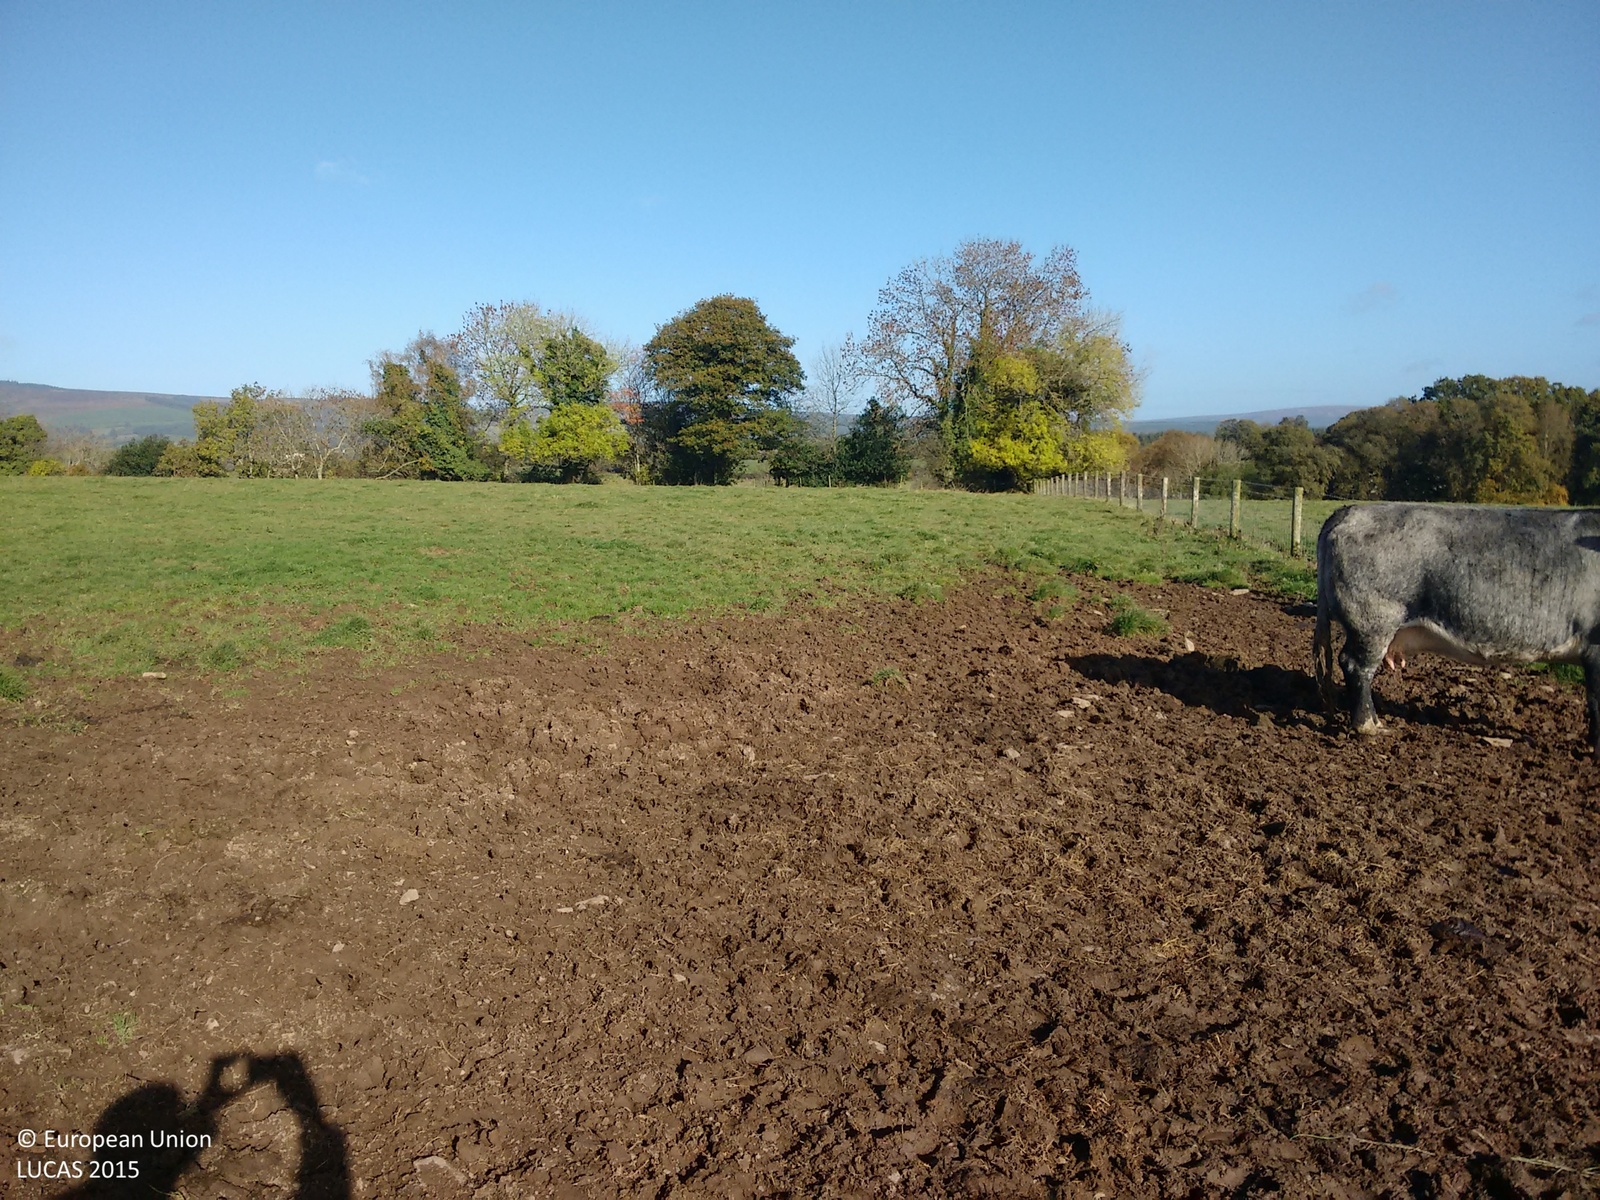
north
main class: Grassland
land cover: Grassland without tree/shrub cover
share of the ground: > 75 %
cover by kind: herbaceous plants 100 %
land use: Agriculture (excluding fallow land and kitchen gardens)
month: October
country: IE
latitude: 52.9992
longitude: -7.6106
